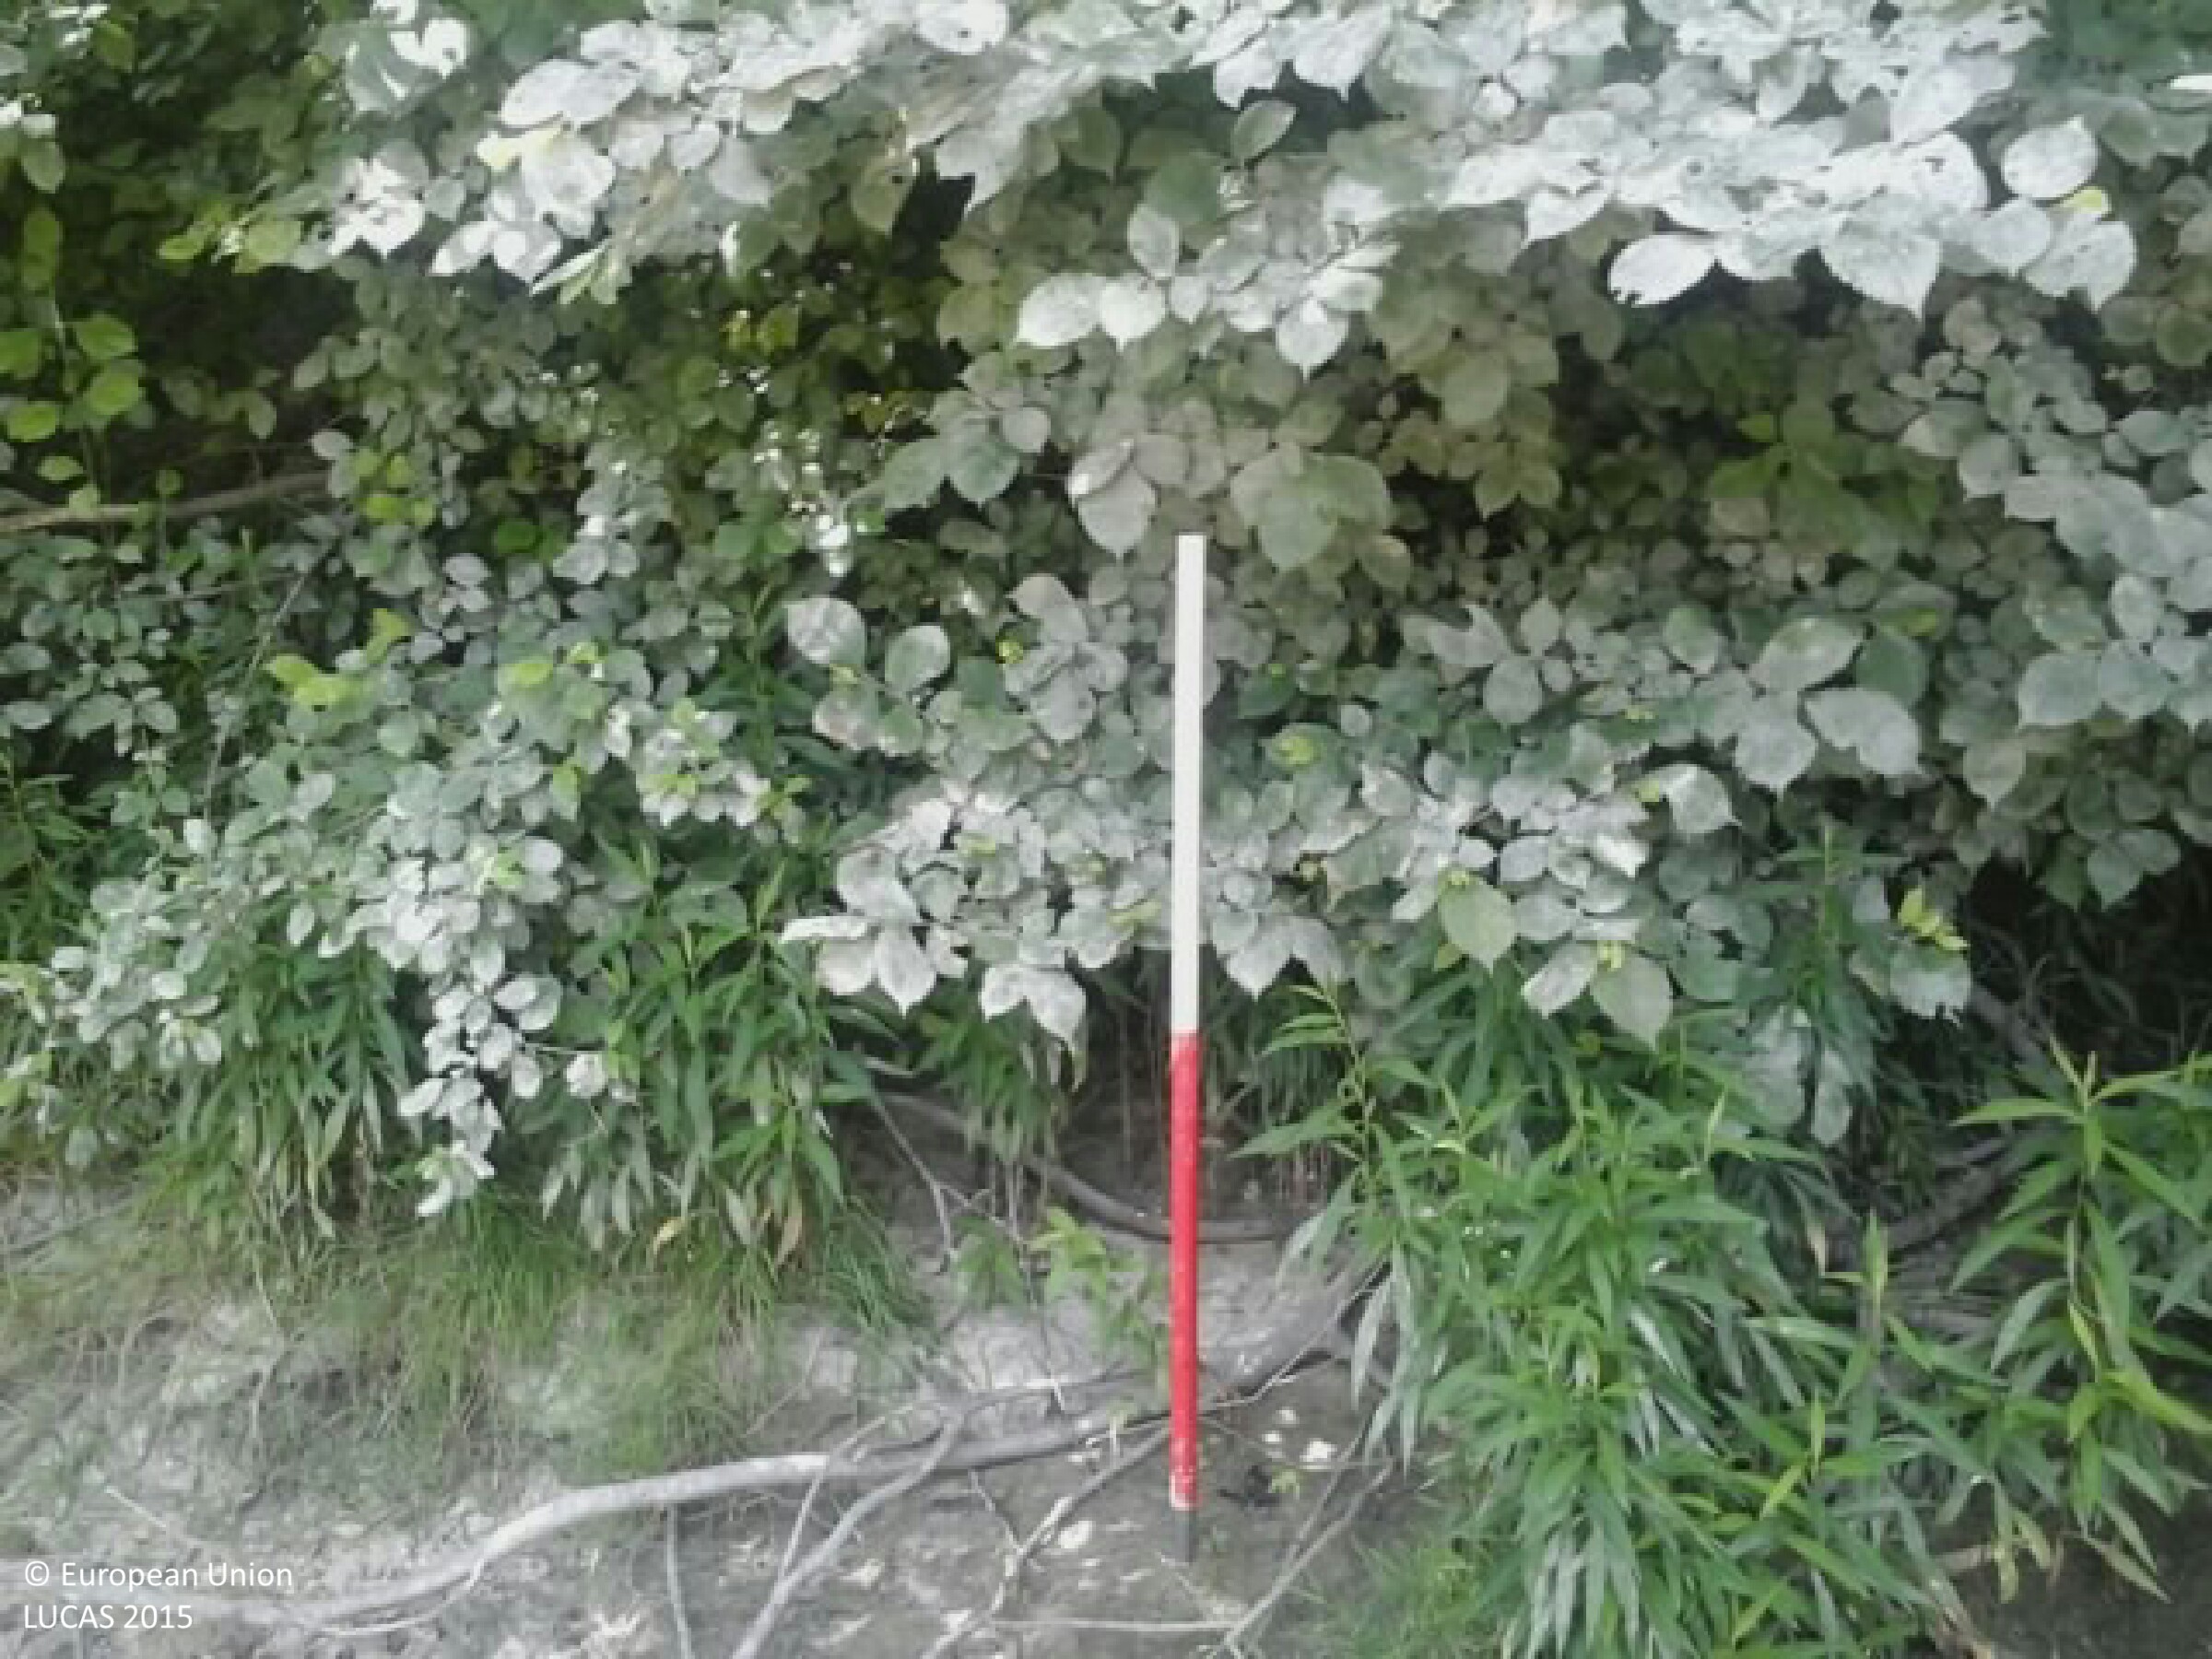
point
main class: Woodland
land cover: Broadleaved woodland
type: mesophytic deciduous forest
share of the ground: > 75 %
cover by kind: broadleaved forest trees 75 %, unconsolidated bare surface 20 %, herbaceous plants 5 %
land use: Semi-natural and natural areas not in use
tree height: > 5 m
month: June
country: HU
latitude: 46.8653
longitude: 18.9218
